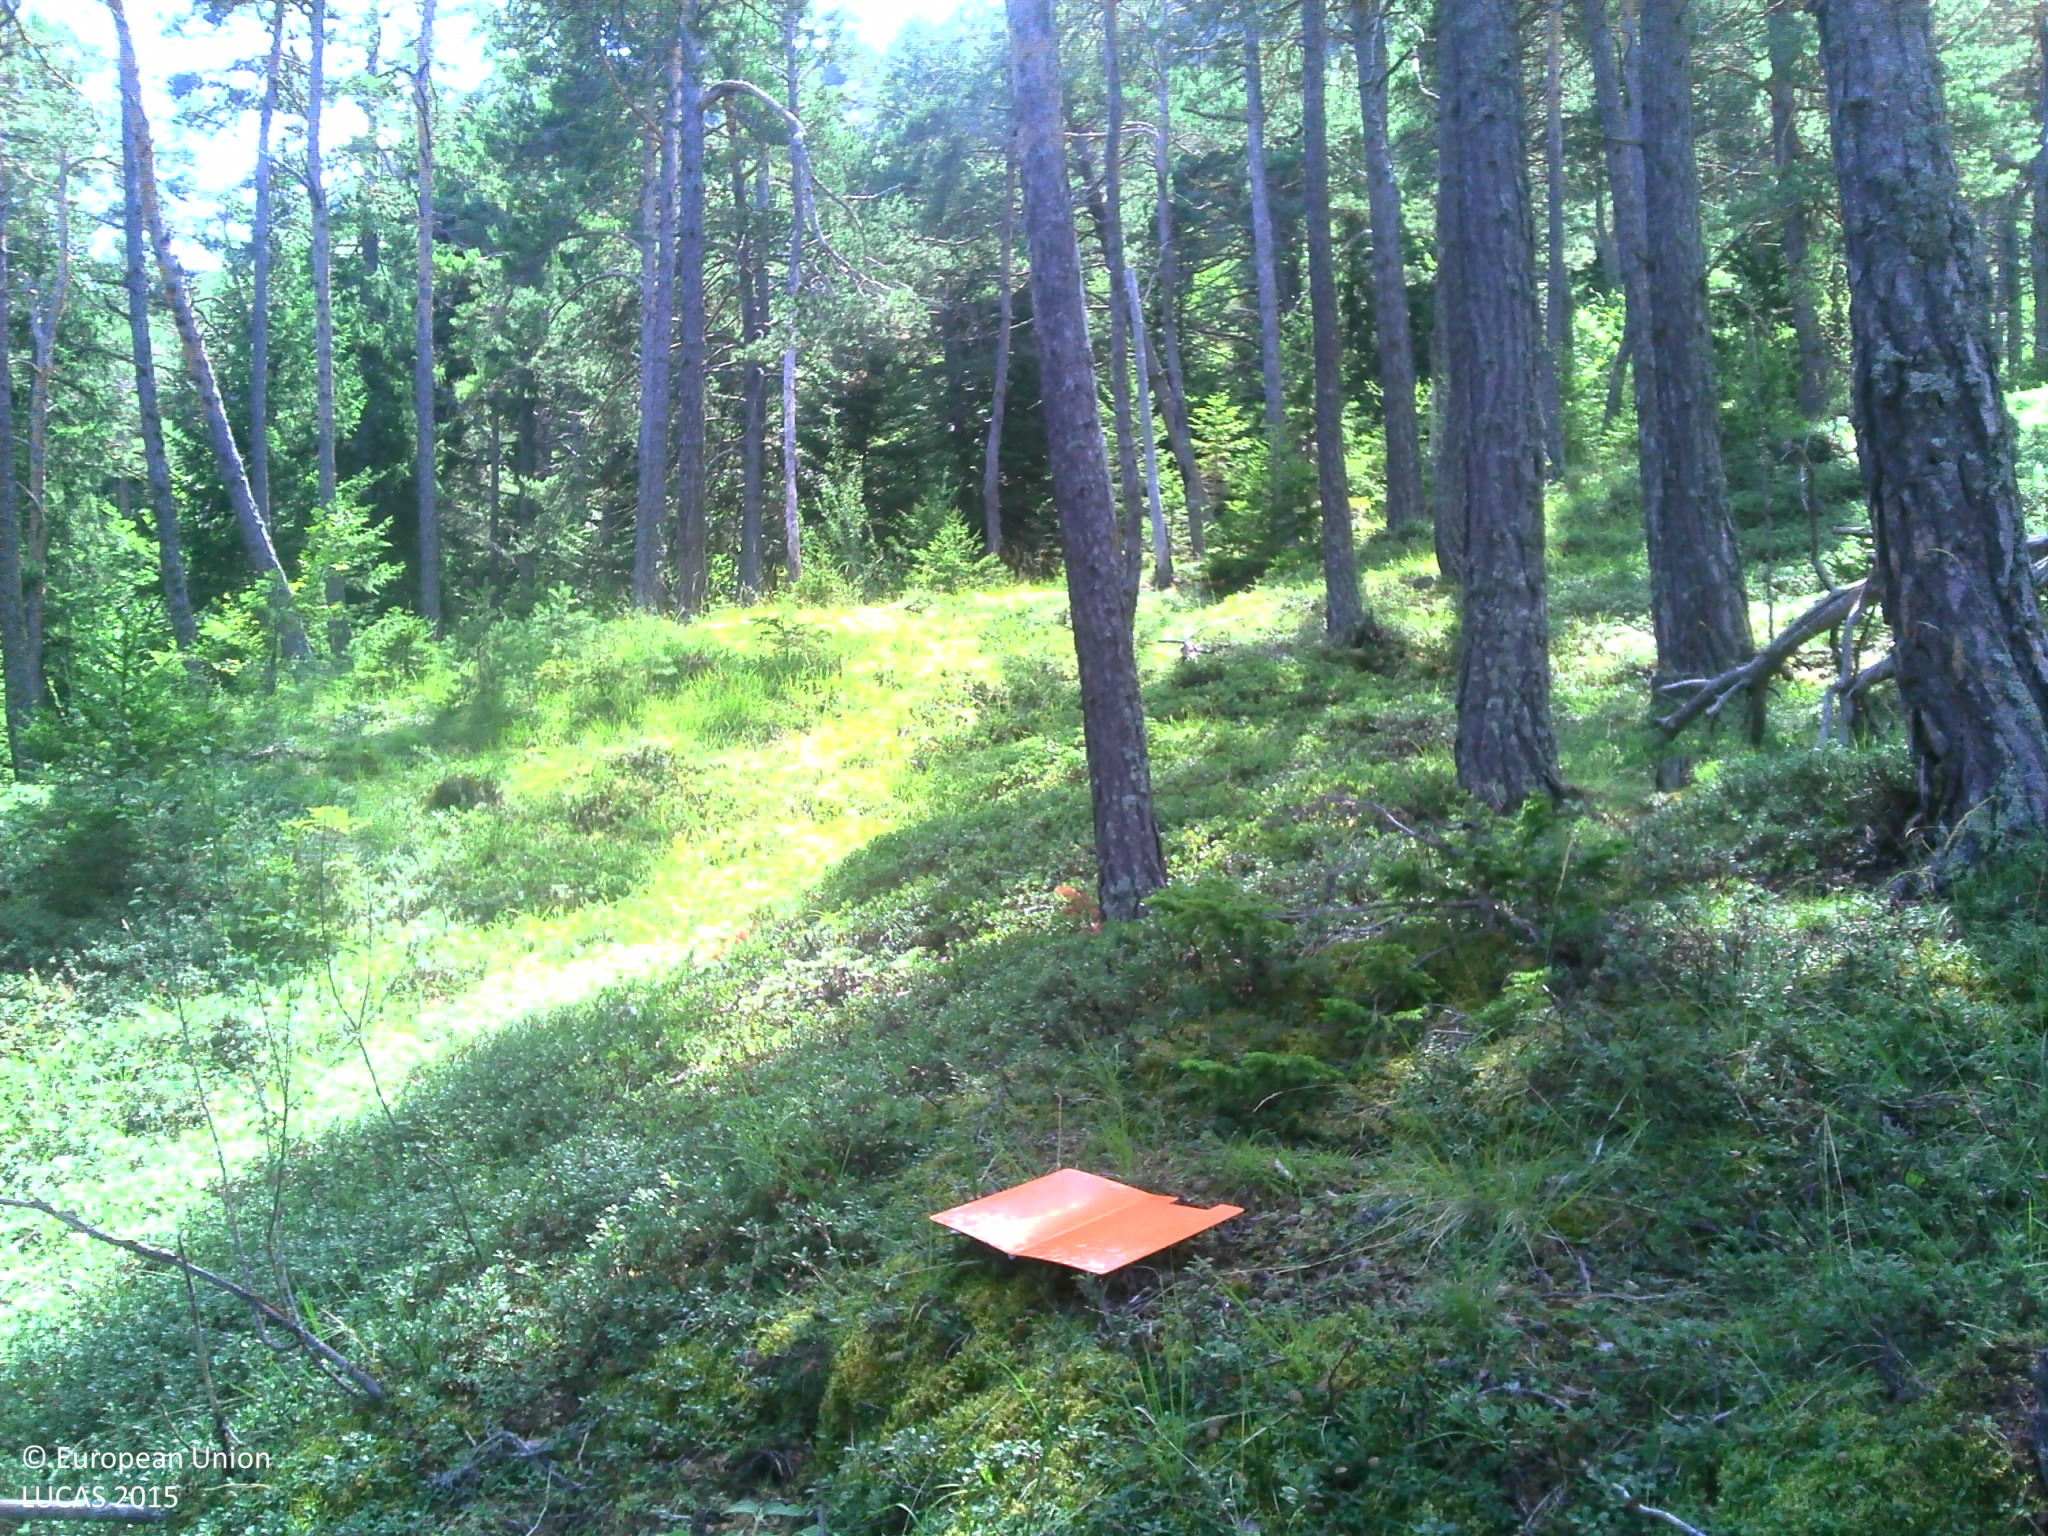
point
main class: Woodland
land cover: Pine dominated coniferous woodland
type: alpine coniferous forest
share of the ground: 50 - 75 %
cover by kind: coniferous forest trees 65 %, lichens and mosses 15 %, shrubs 10 %, herbaceous plants 10 %
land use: Forestry
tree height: > 5 m
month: August
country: FR
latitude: 44.3570
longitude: 6.3057
